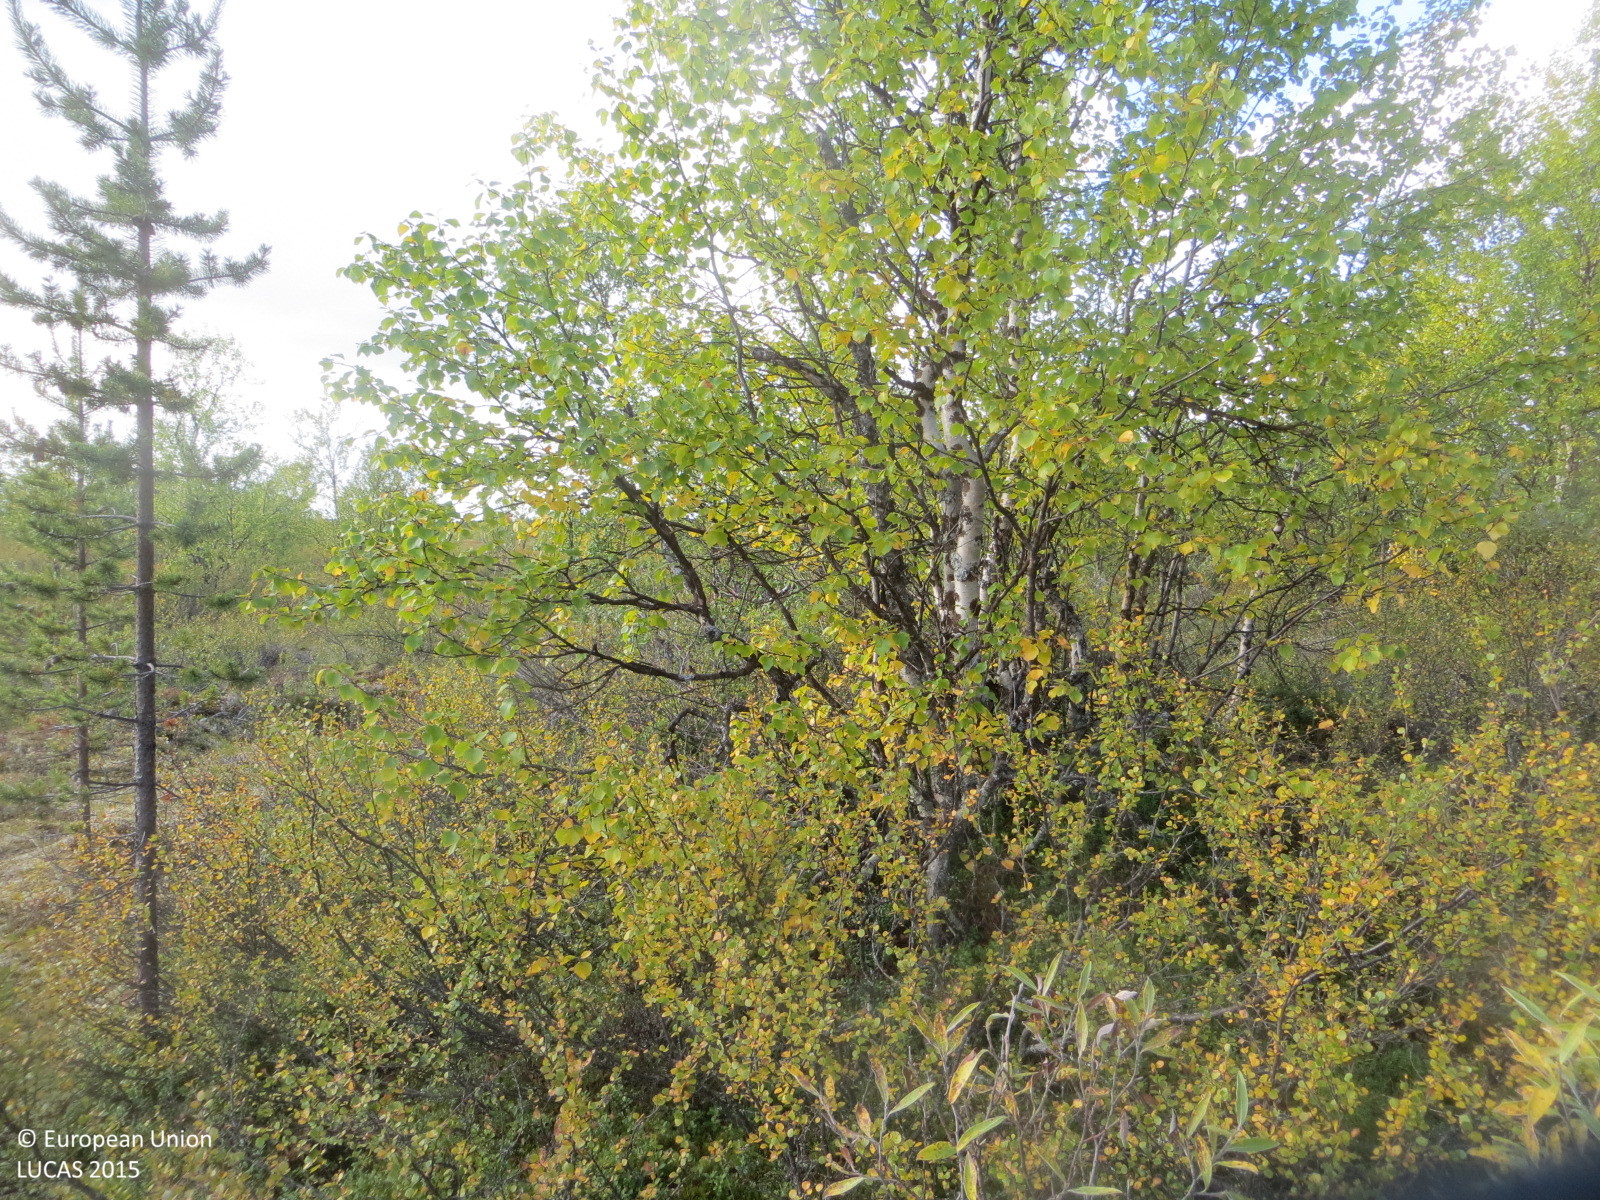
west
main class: Woodland
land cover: Pine dominated mixed woodland
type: boreal forest
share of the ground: 50 - 75 %
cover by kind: shrubs 50 %, broadleaved forest trees 35 %, coniferous forest trees 15 %
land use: Semi-natural and natural areas not in use
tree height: > 5 m
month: September
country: FI
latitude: 68.3999
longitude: 24.3028
